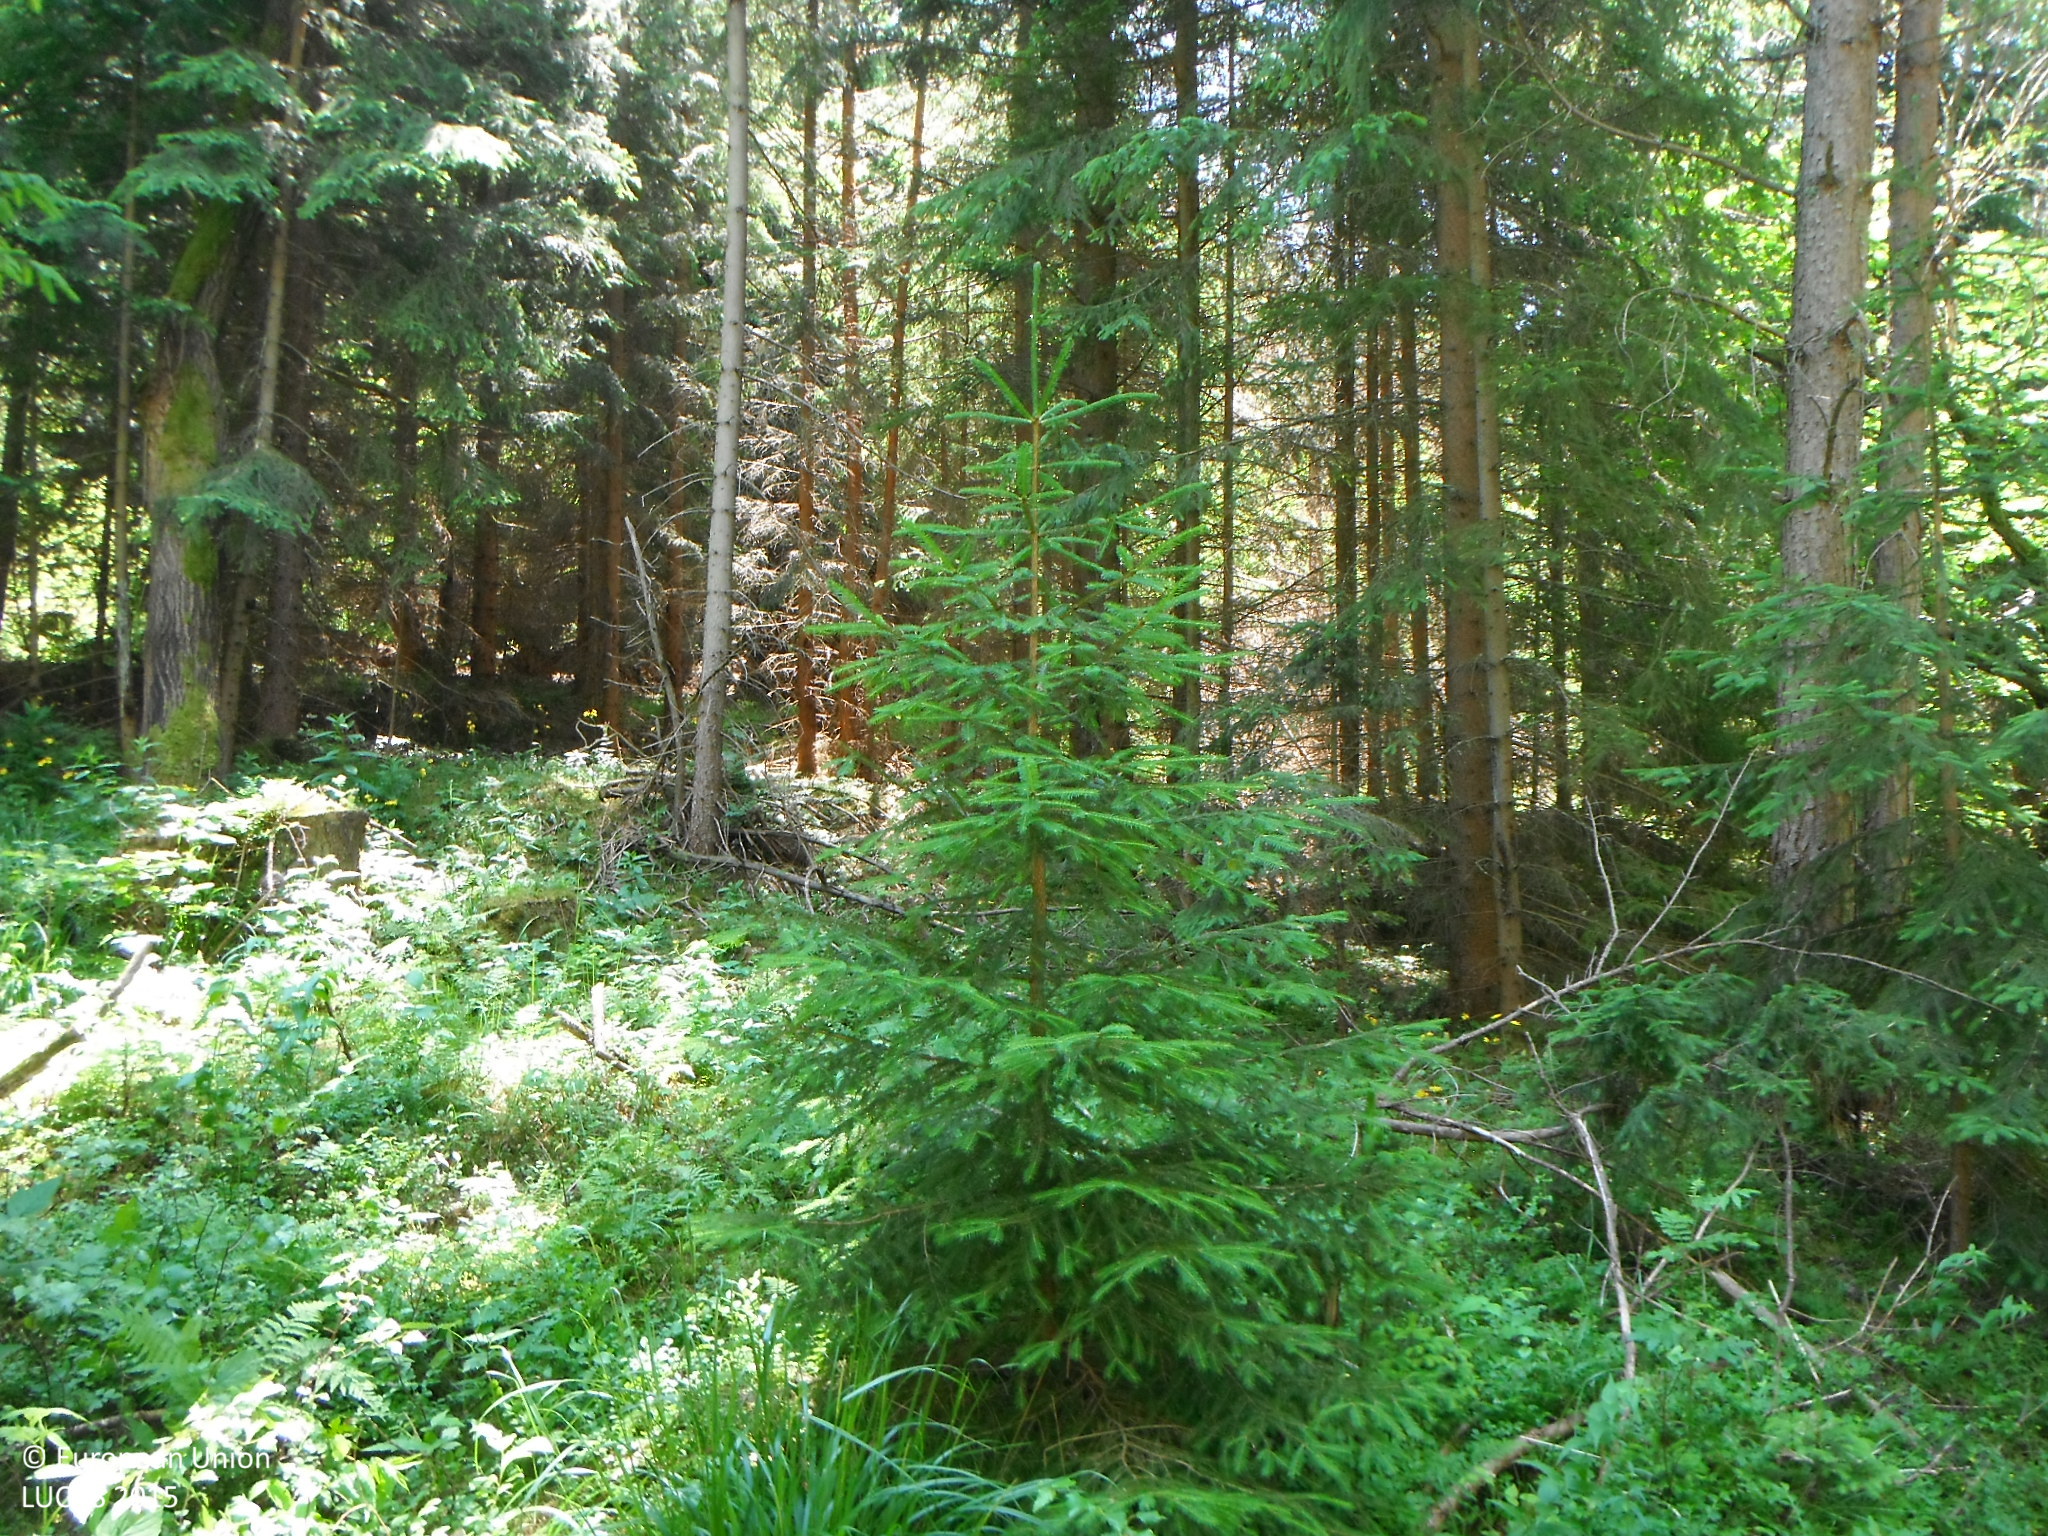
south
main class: Woodland
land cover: Spruce dominated coniferous woodland
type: alpine coniferous forest
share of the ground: > 75 %
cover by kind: coniferous forest trees 80 %, broadleaved forest trees 20 %
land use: Forestry
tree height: > 5 m
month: July
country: SK
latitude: 49.3494
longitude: 19.3166
